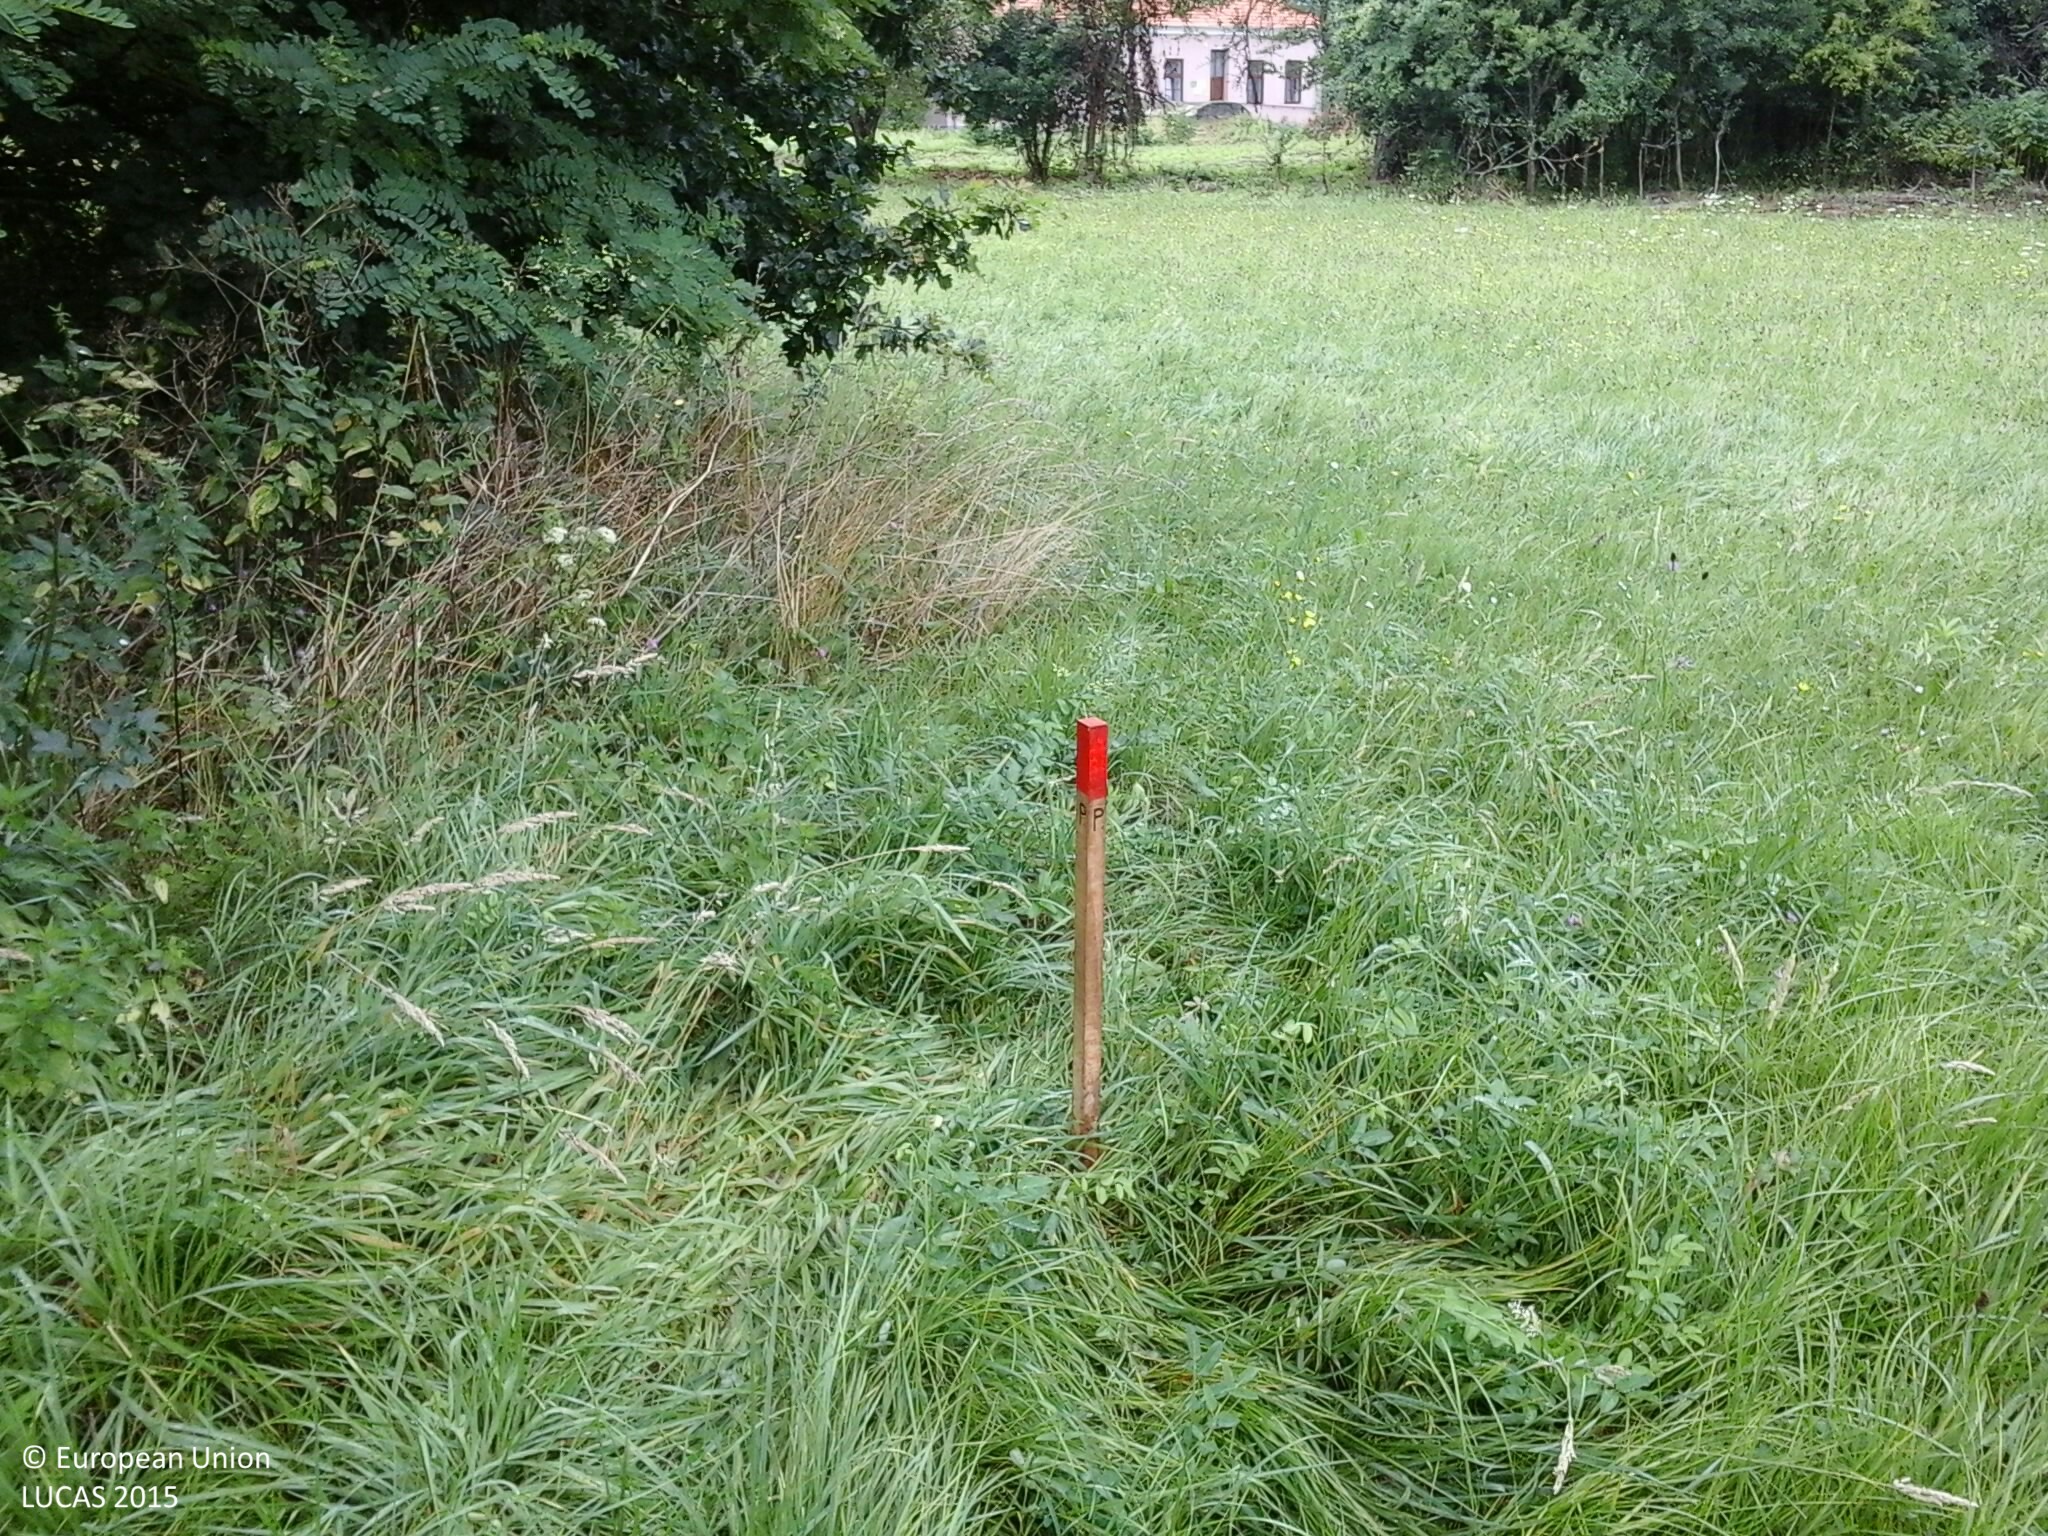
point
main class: Grassland
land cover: Grassland without tree/shrub cover
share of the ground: > 75 %
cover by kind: herbaceous plants 100 %
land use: Agriculture (excluding fallow land and kitchen gardens)
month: July
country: HU
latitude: 46.7390
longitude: 16.3751
